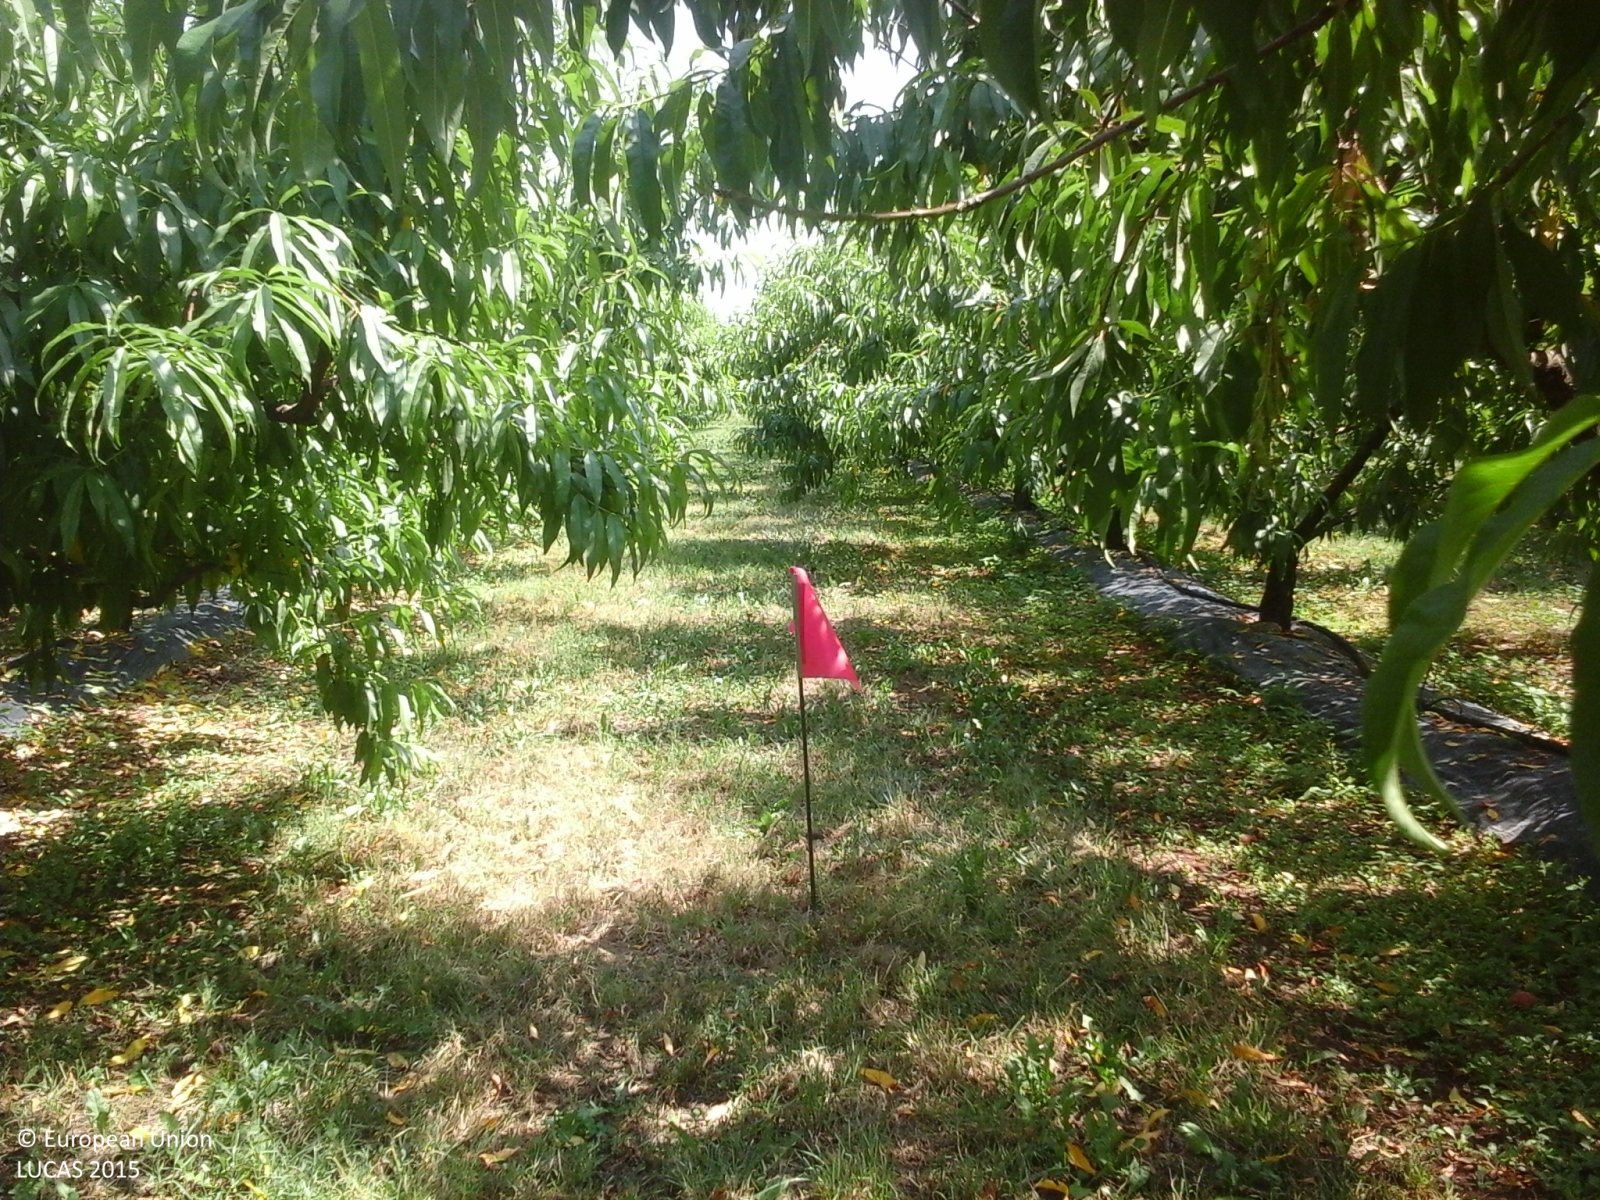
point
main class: Cropland
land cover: Other fruit trees and berries
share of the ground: > 75 %
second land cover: Grassland without tree/shrub cover
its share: > 75 %
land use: Agriculture (excluding fallow land and kitchen gardens)
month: July
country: IT
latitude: 45.2854
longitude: 10.7508
